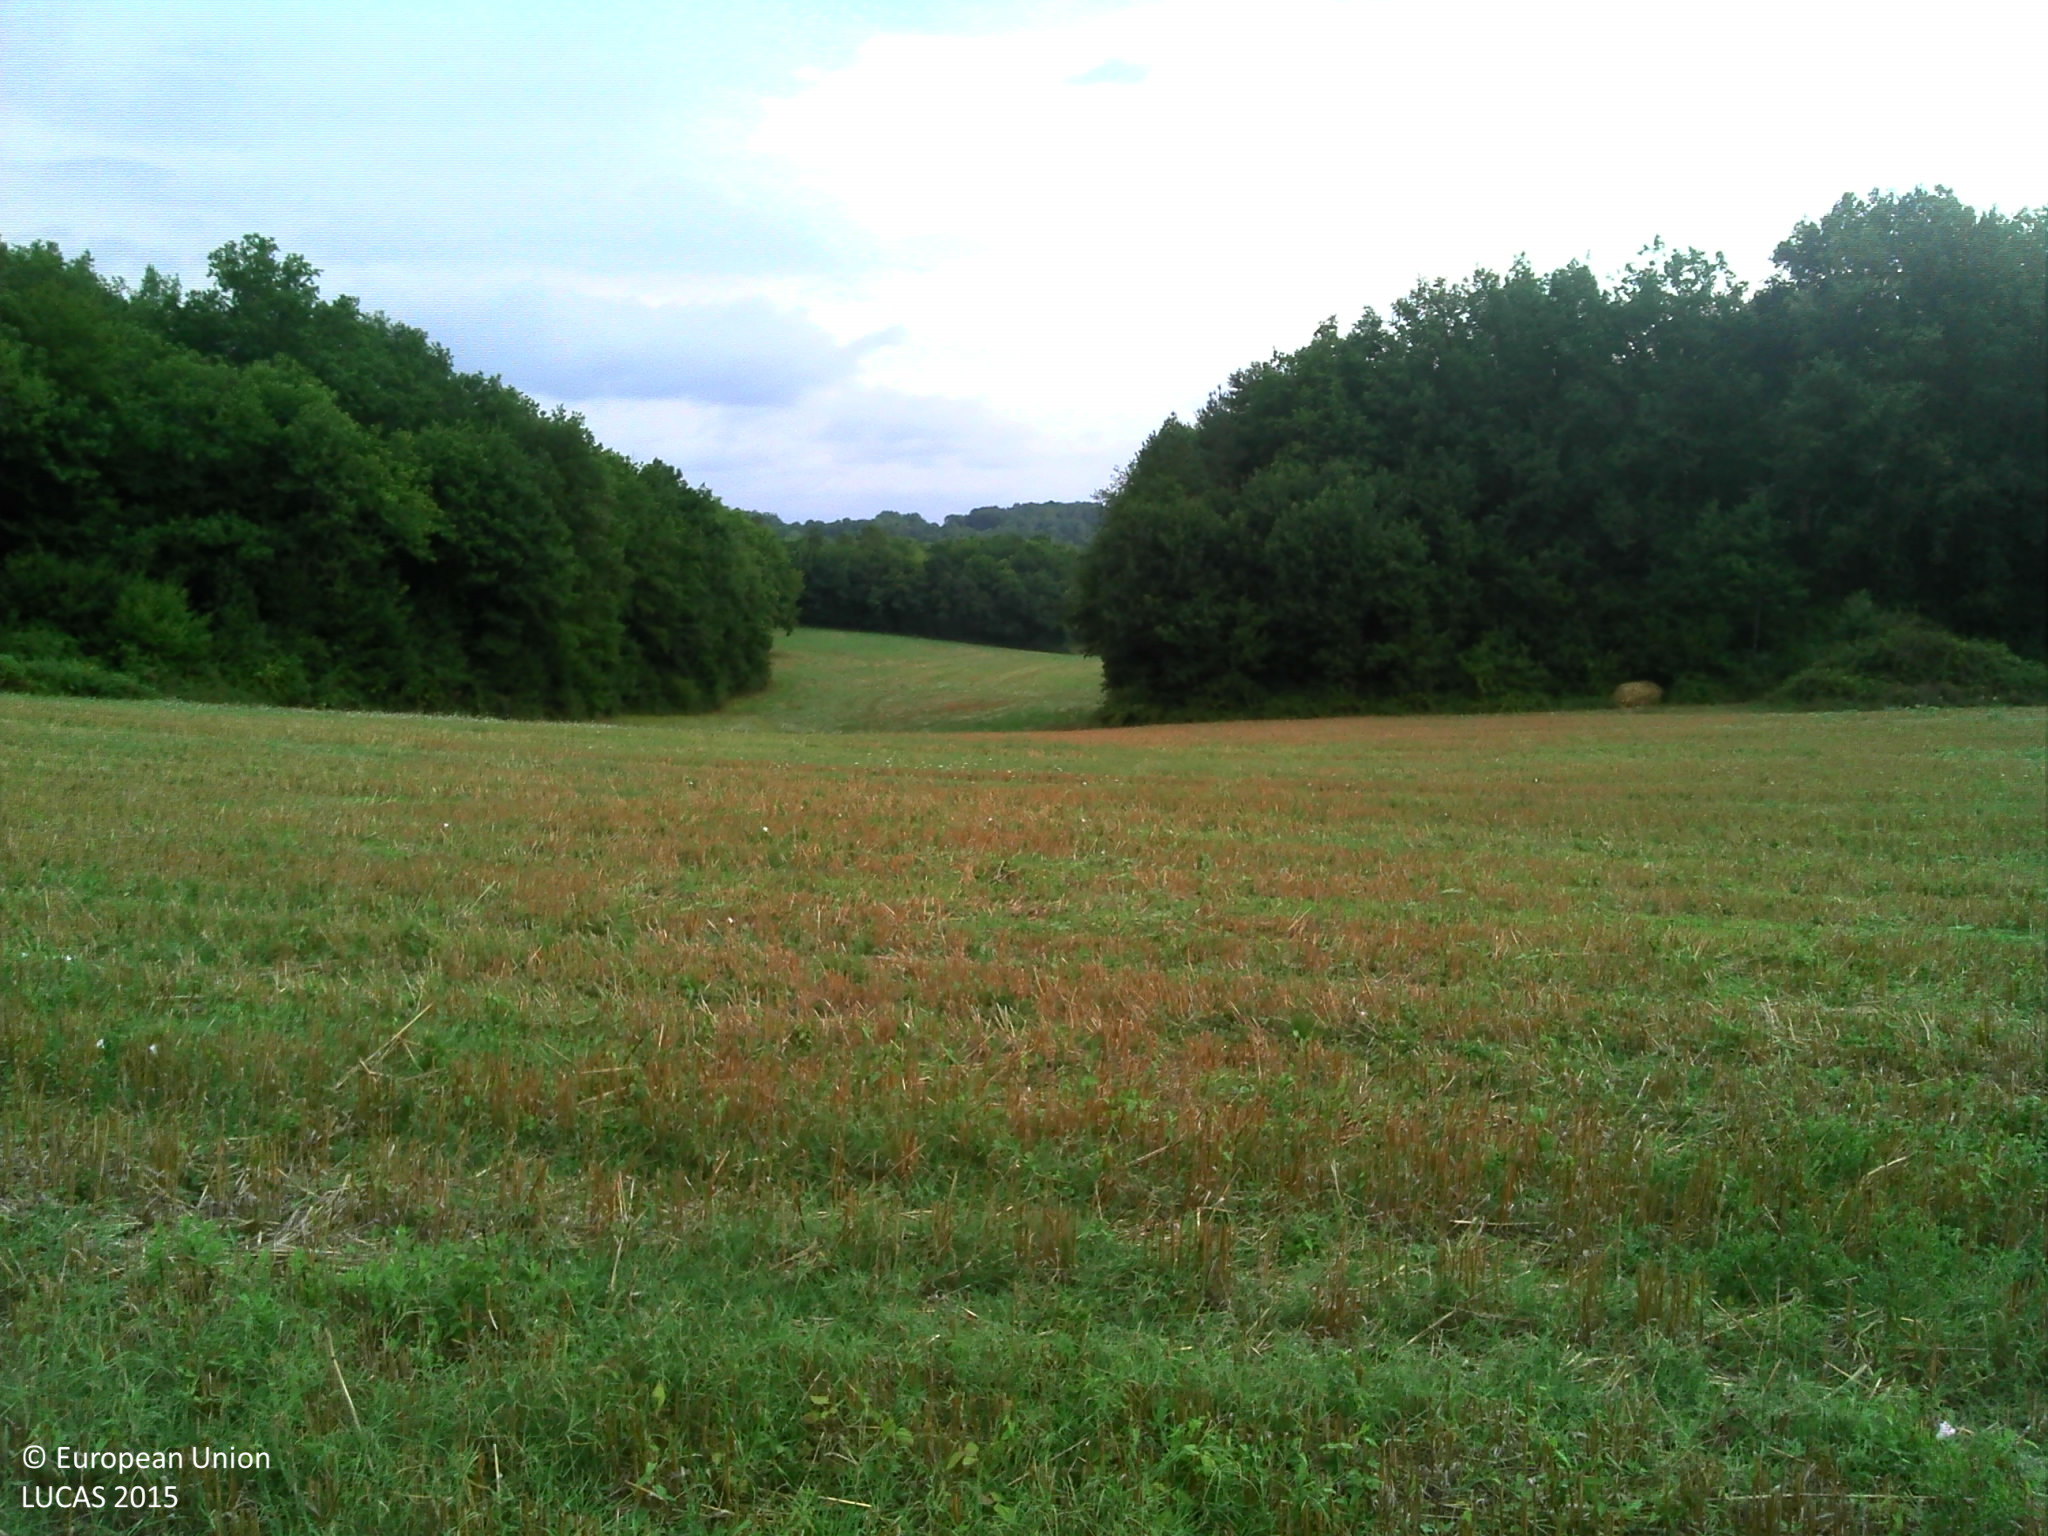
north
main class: Cropland
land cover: Temporary grasslands
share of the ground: > 75 %
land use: Agriculture (excluding fallow land and kitchen gardens)
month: August
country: FR
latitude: 45.3881
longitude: 0.7550
